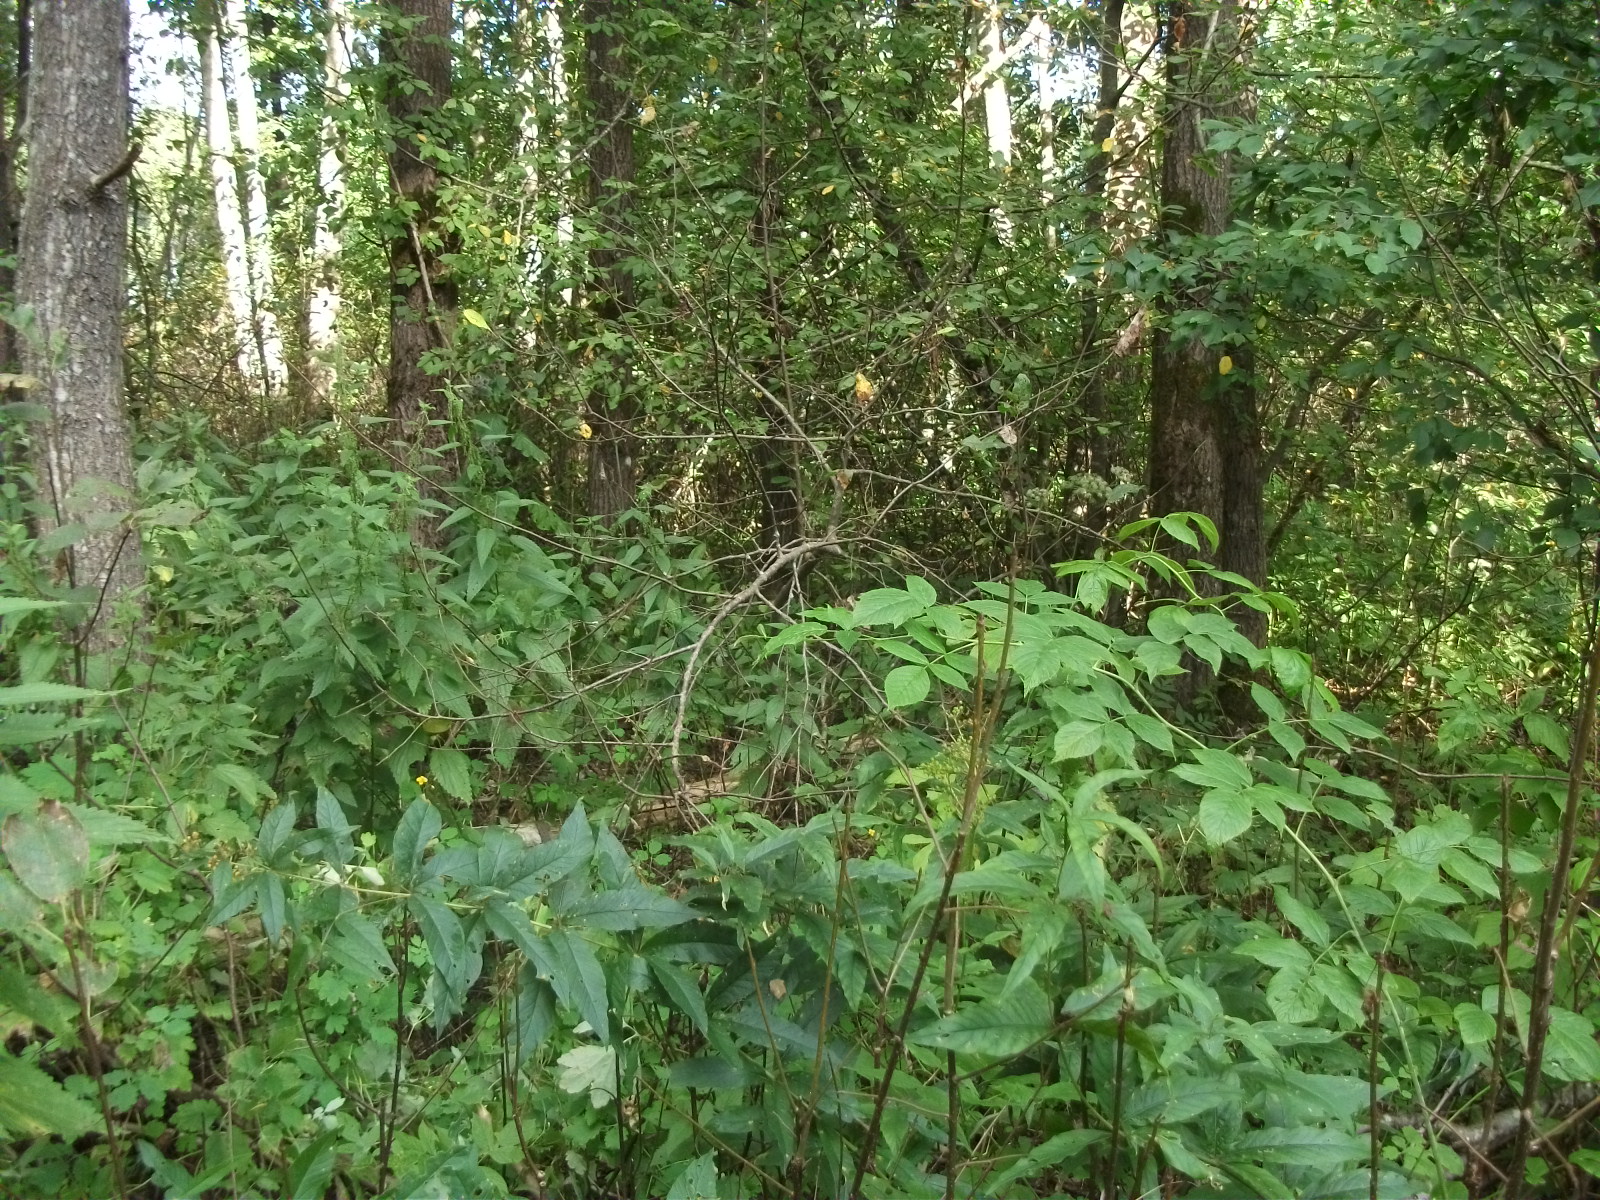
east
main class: Woodland
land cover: Broadleaved woodland
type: non-riverine alder, birch or aspen forest
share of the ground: > 75 %
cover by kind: broadleaved forest trees 80 %, shrubs 10 %, herbaceous plants 10 %
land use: Forestry
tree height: > 5 m
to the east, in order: Broadleaved woodland; Ditches and canals; Spontaneously vegetated surfaces; Broadleaved woodland
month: August
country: LV
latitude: 56.3961
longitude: 26.3615
